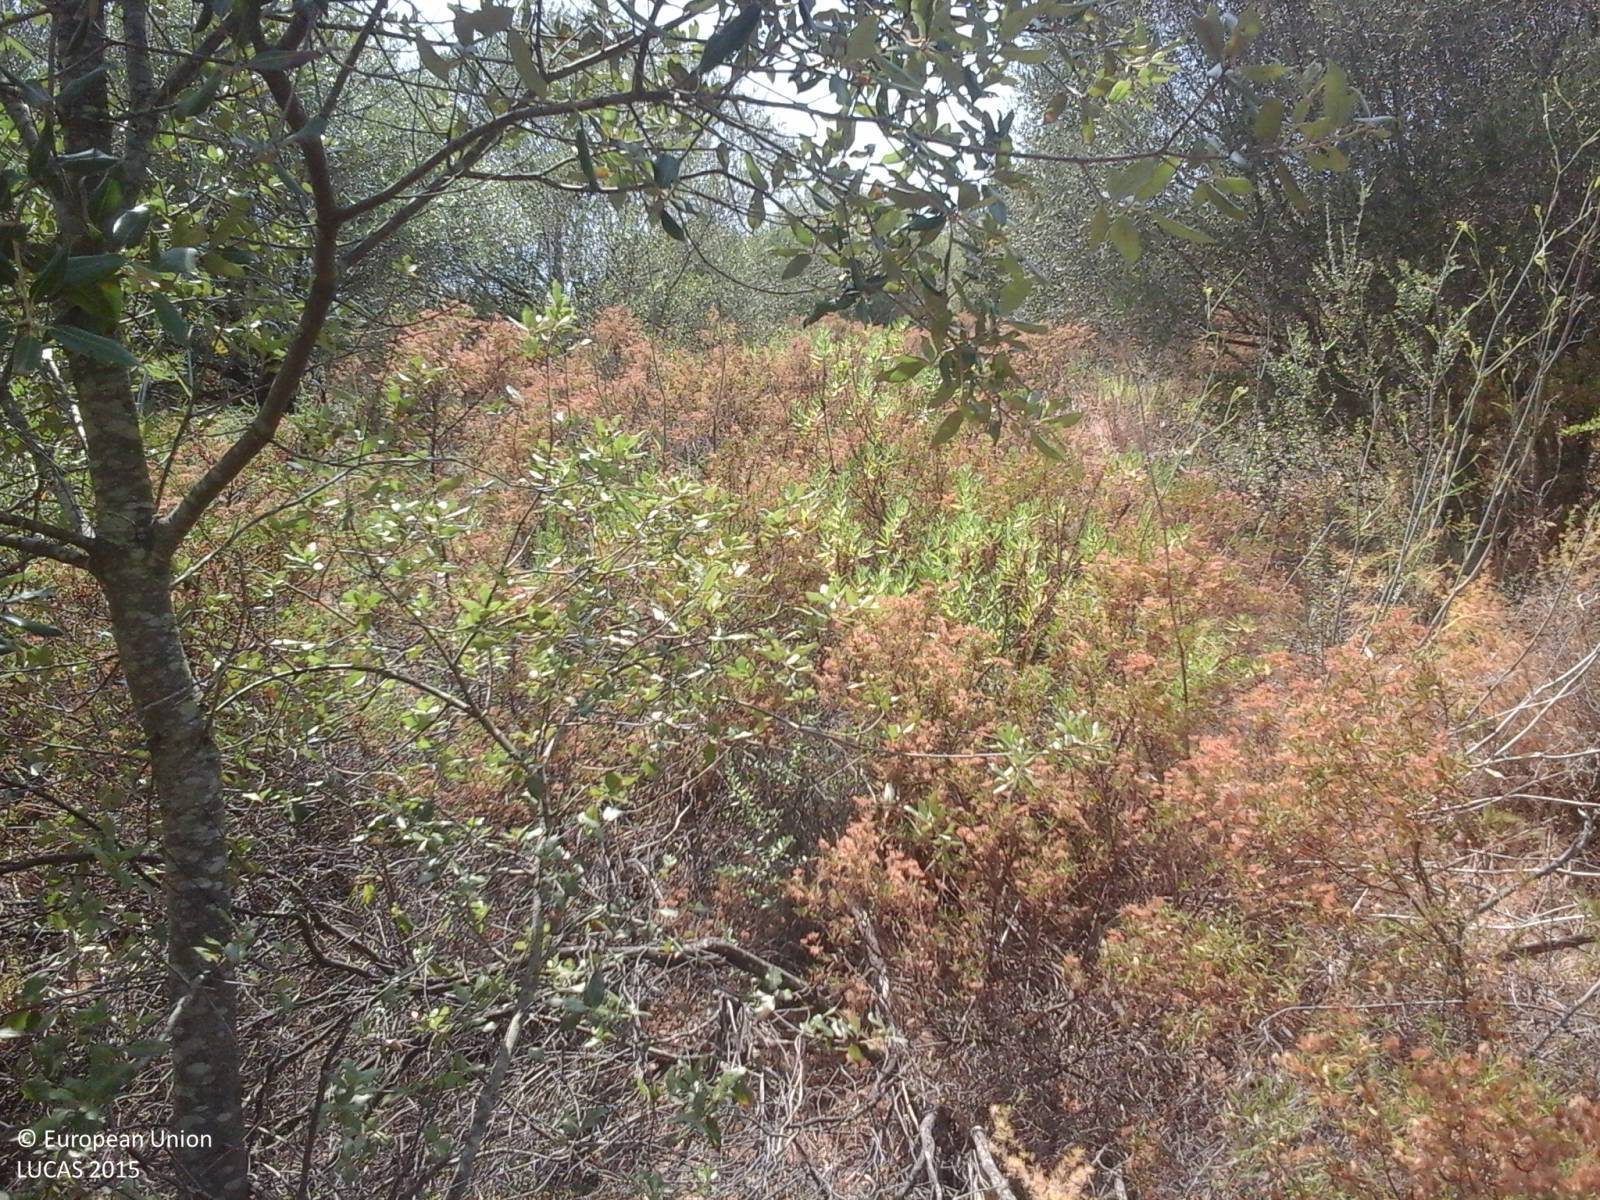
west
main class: Shrubland
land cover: Shrubland with sparse tree cover
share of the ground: > 75 %
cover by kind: shrubs 95 %, broadleaved forest trees 5 %
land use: Abandoned areas
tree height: > 5 m
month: July
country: IT
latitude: 40.8275
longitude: 9.5870
